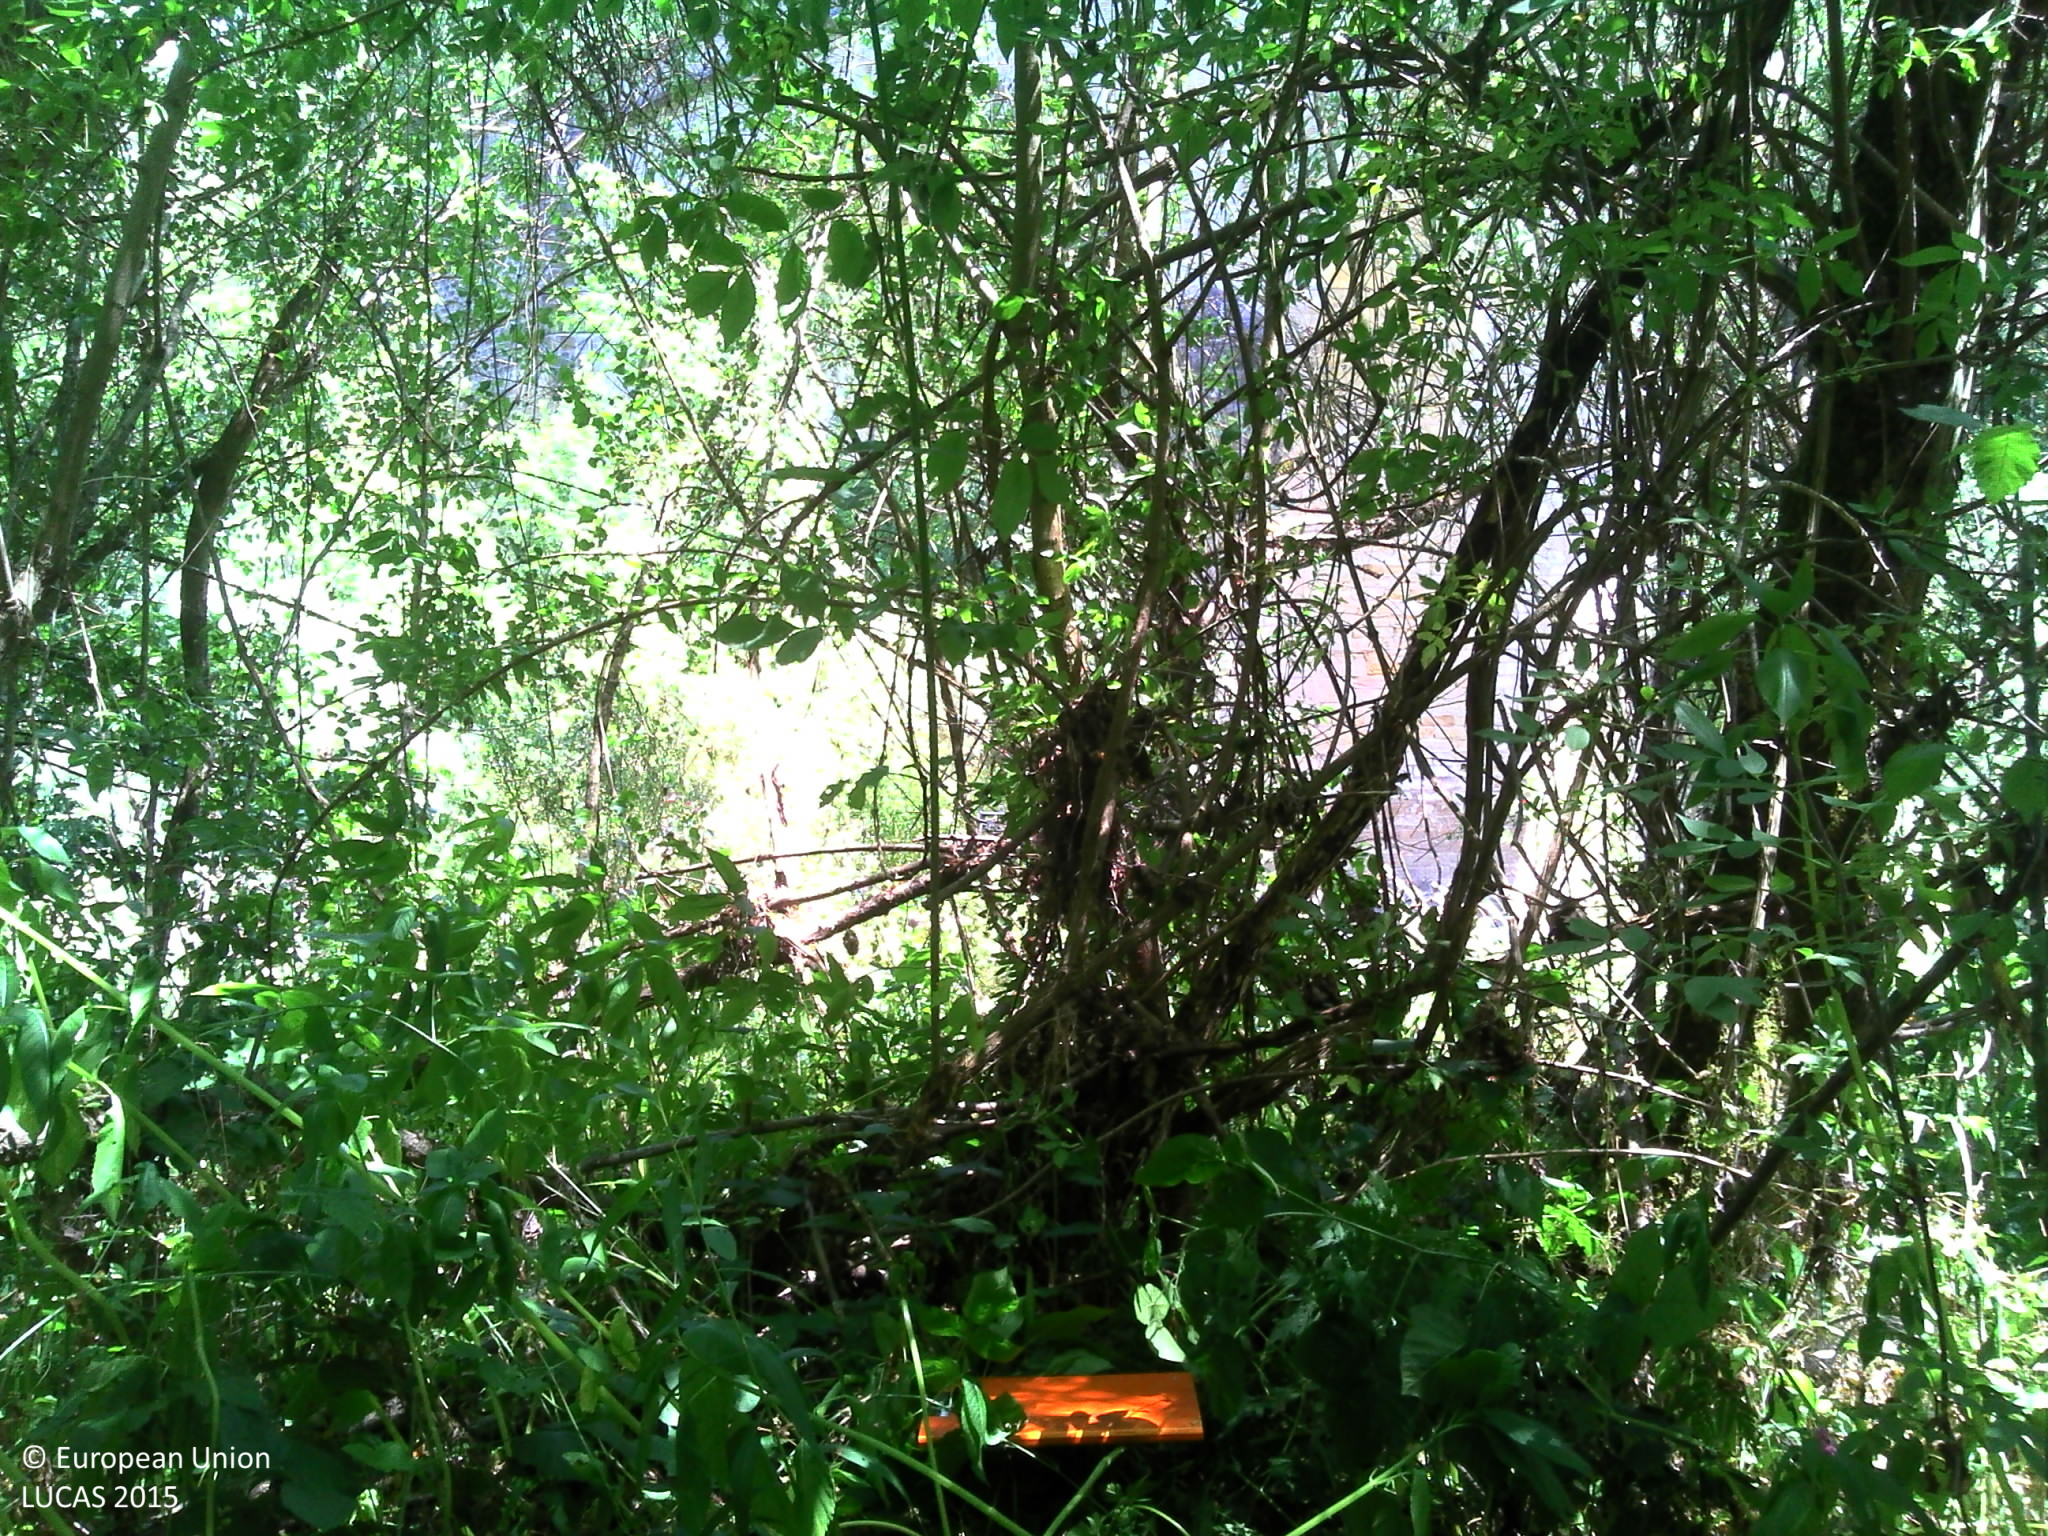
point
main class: Woodland
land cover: Broadleaved woodland
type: floodplain forest
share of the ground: > 75 %
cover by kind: broadleaved forest trees 95 %, coniferous forest trees 5 %
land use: Abandoned areas
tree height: > 5 m
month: July
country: FR
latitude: 44.4714
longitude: 3.2039
